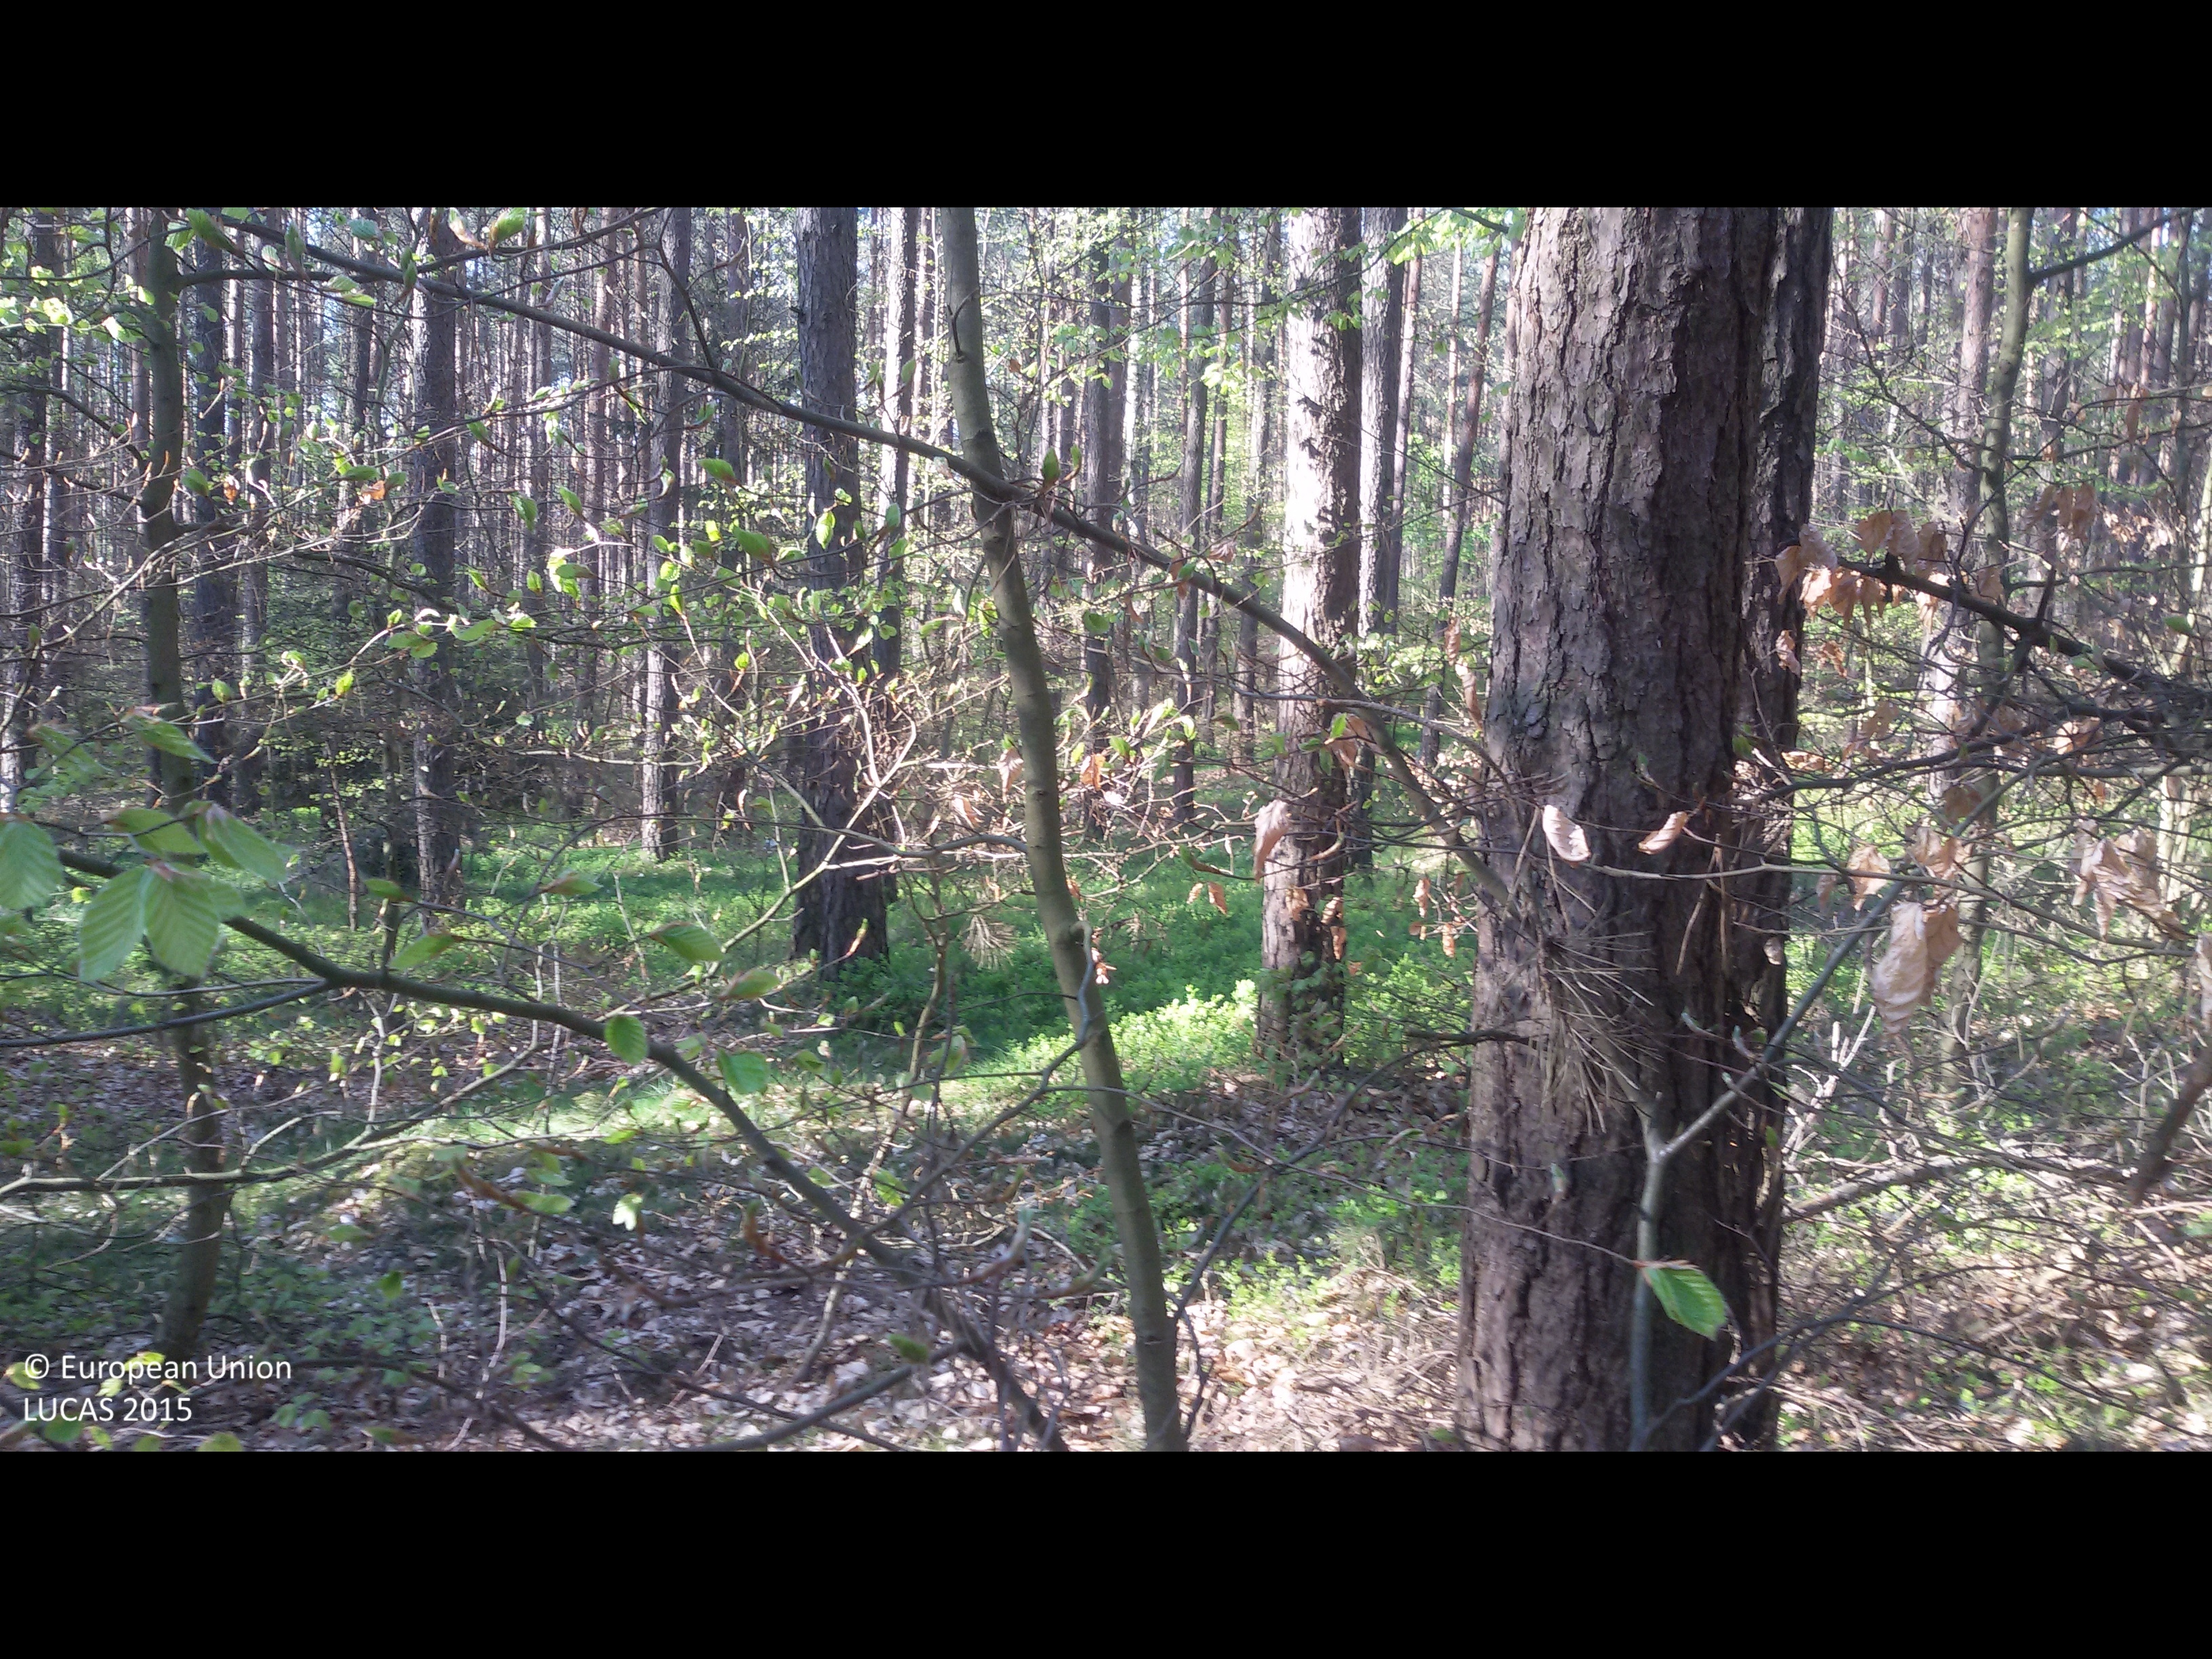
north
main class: Woodland
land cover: Pine dominated mixed woodland
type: hemiboreal forest and nemoral coniferous forest and mixed broadleaved-coniferous forest
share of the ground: > 75 %
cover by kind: coniferous forest trees 60 %, broadleaved forest trees 25 %, shrubs 10 %, herbaceous plants 5 %
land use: Forestry
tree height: > 5 m
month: May
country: PL
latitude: 52.9992
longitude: 17.0277
